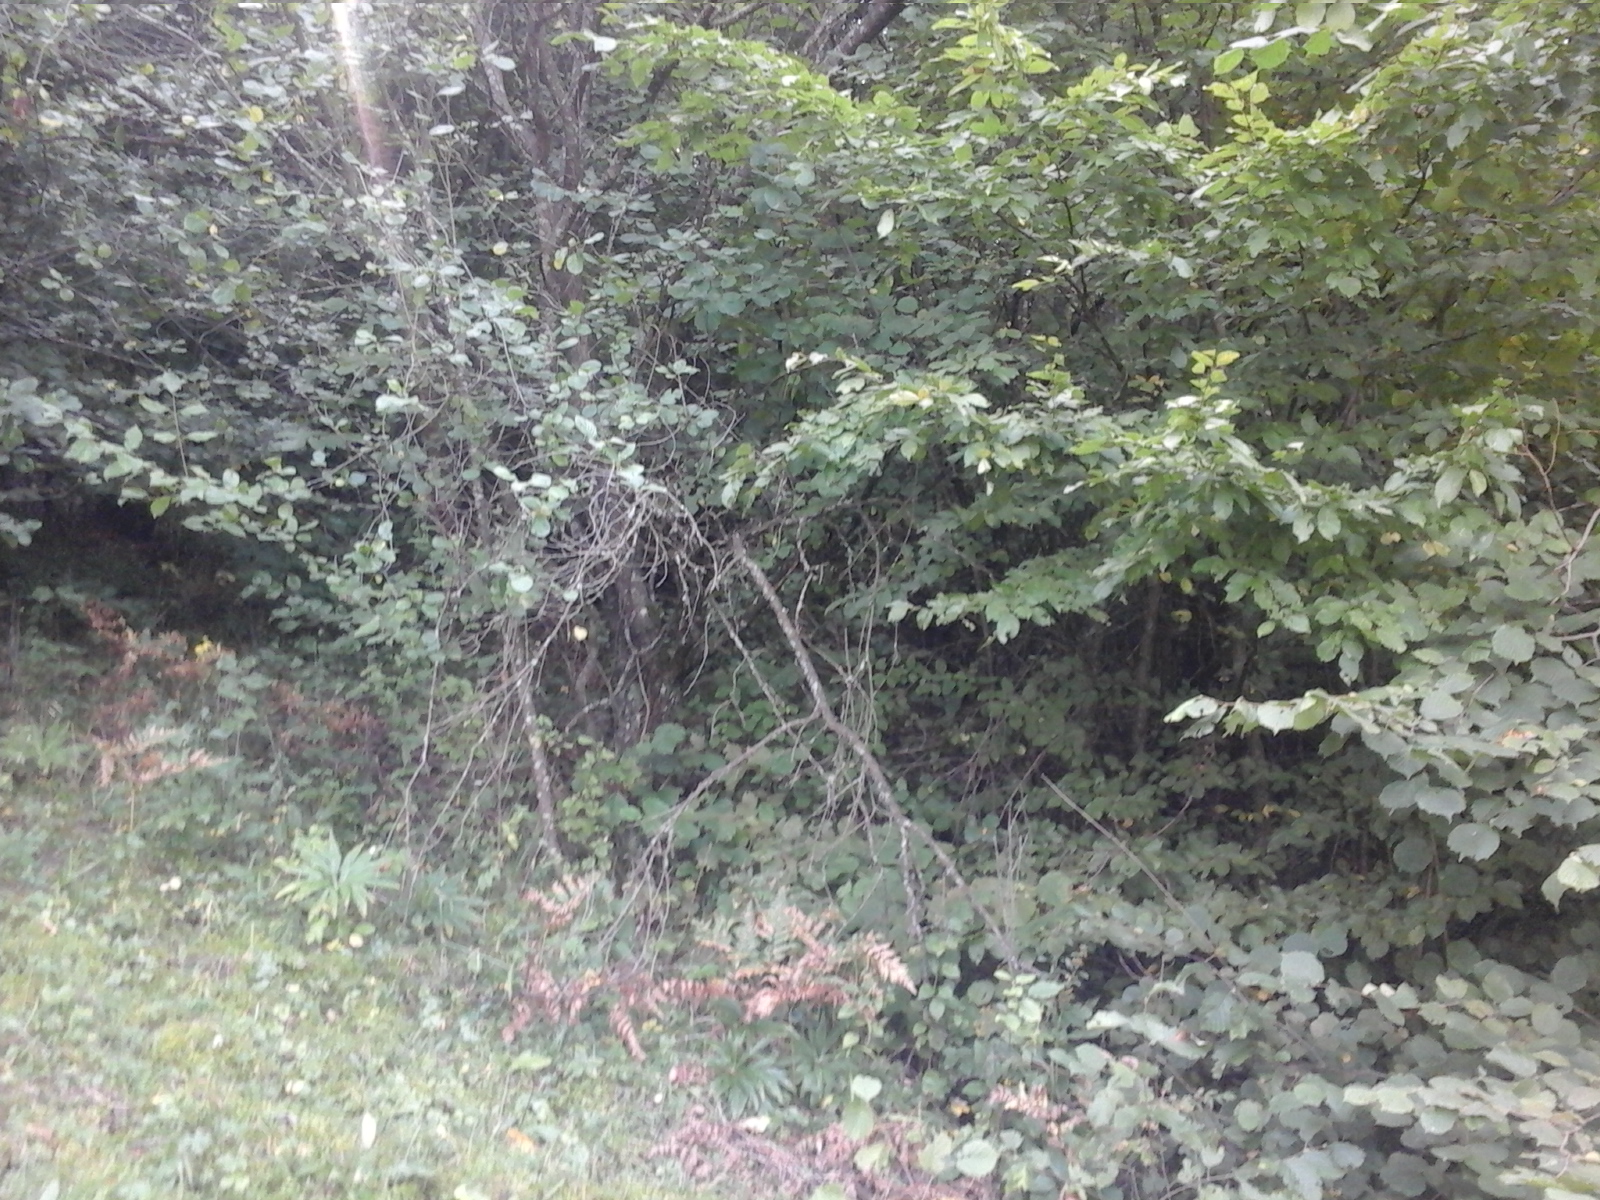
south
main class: Woodland
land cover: Broadleaved woodland
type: beech forest
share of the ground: > 75 %
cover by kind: broadleaved forest trees 100 %
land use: Forestry
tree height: > 5 m
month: September
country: RO
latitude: 47.7634
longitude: 24.1366
